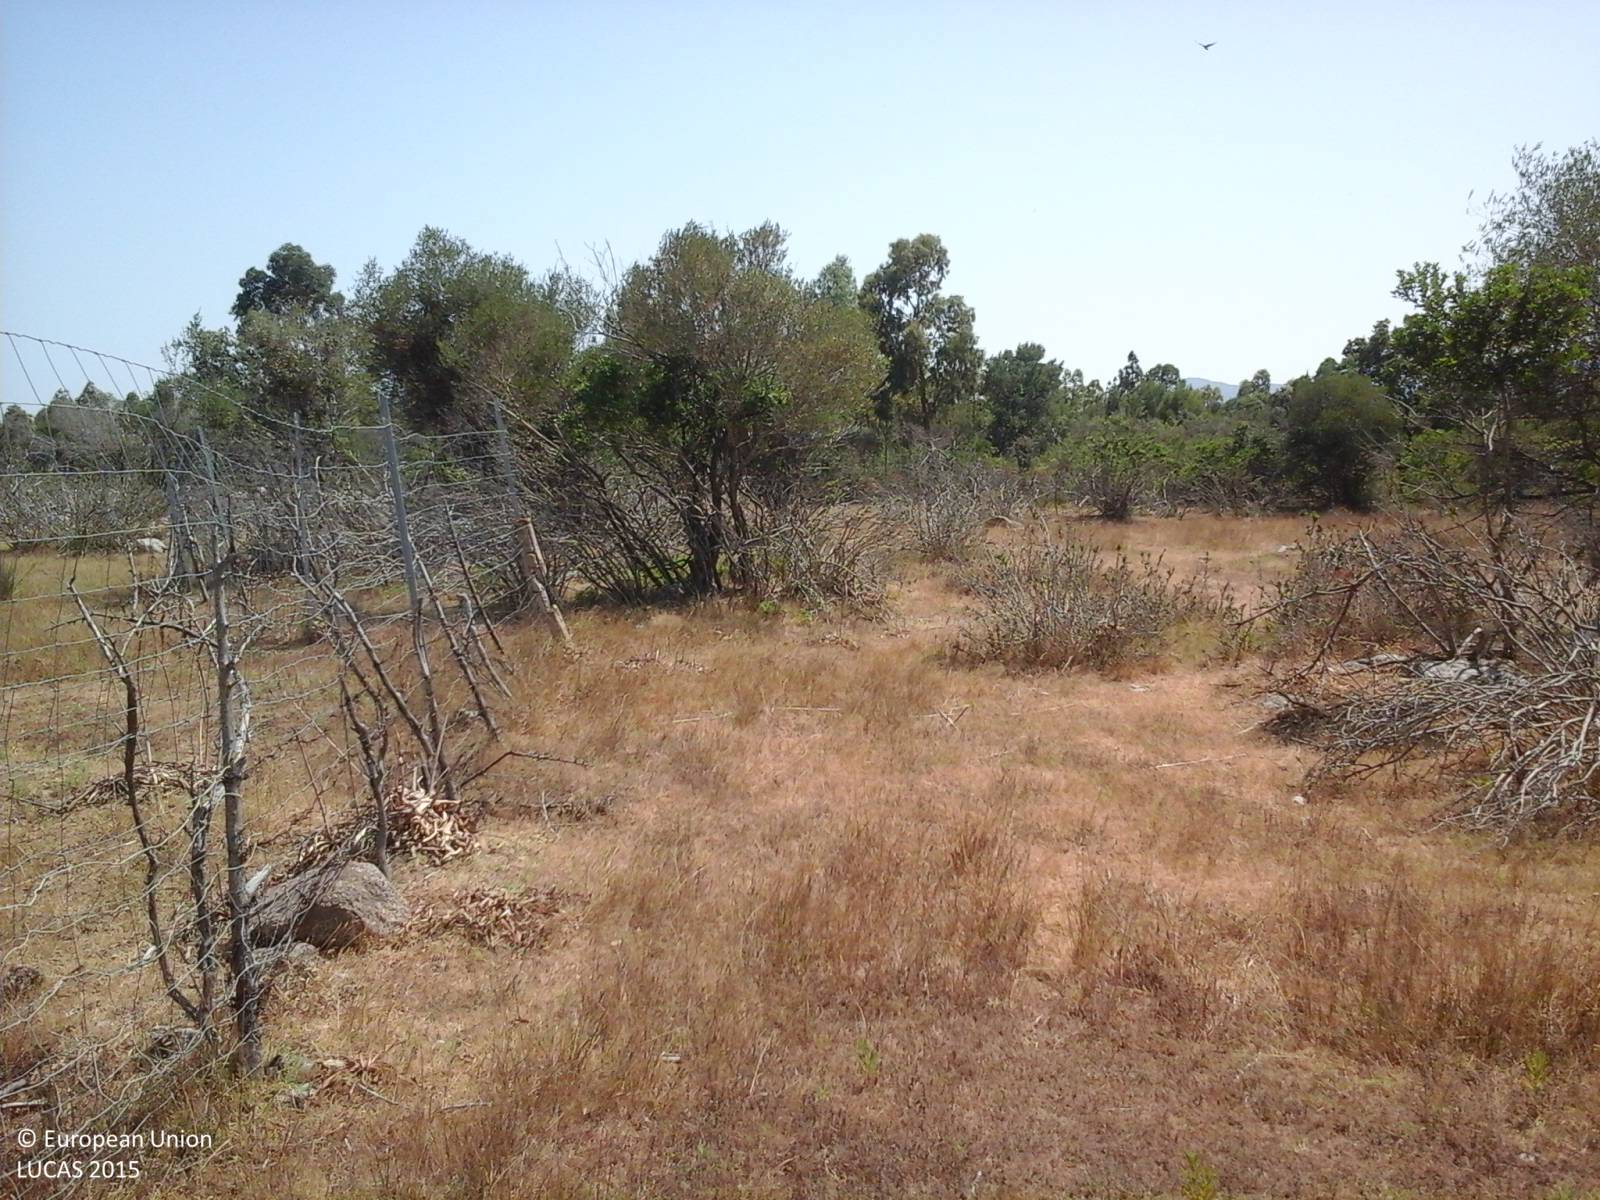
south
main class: Grassland
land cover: Grassland with sparse tree/shrub cover
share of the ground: > 75 %
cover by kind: herbaceous plants 95 %, broadleaved forest trees 5 %
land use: Agriculture (excluding fallow land and kitchen gardens)
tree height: < 5 m
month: July
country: IT
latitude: 40.7916
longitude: 9.6580
